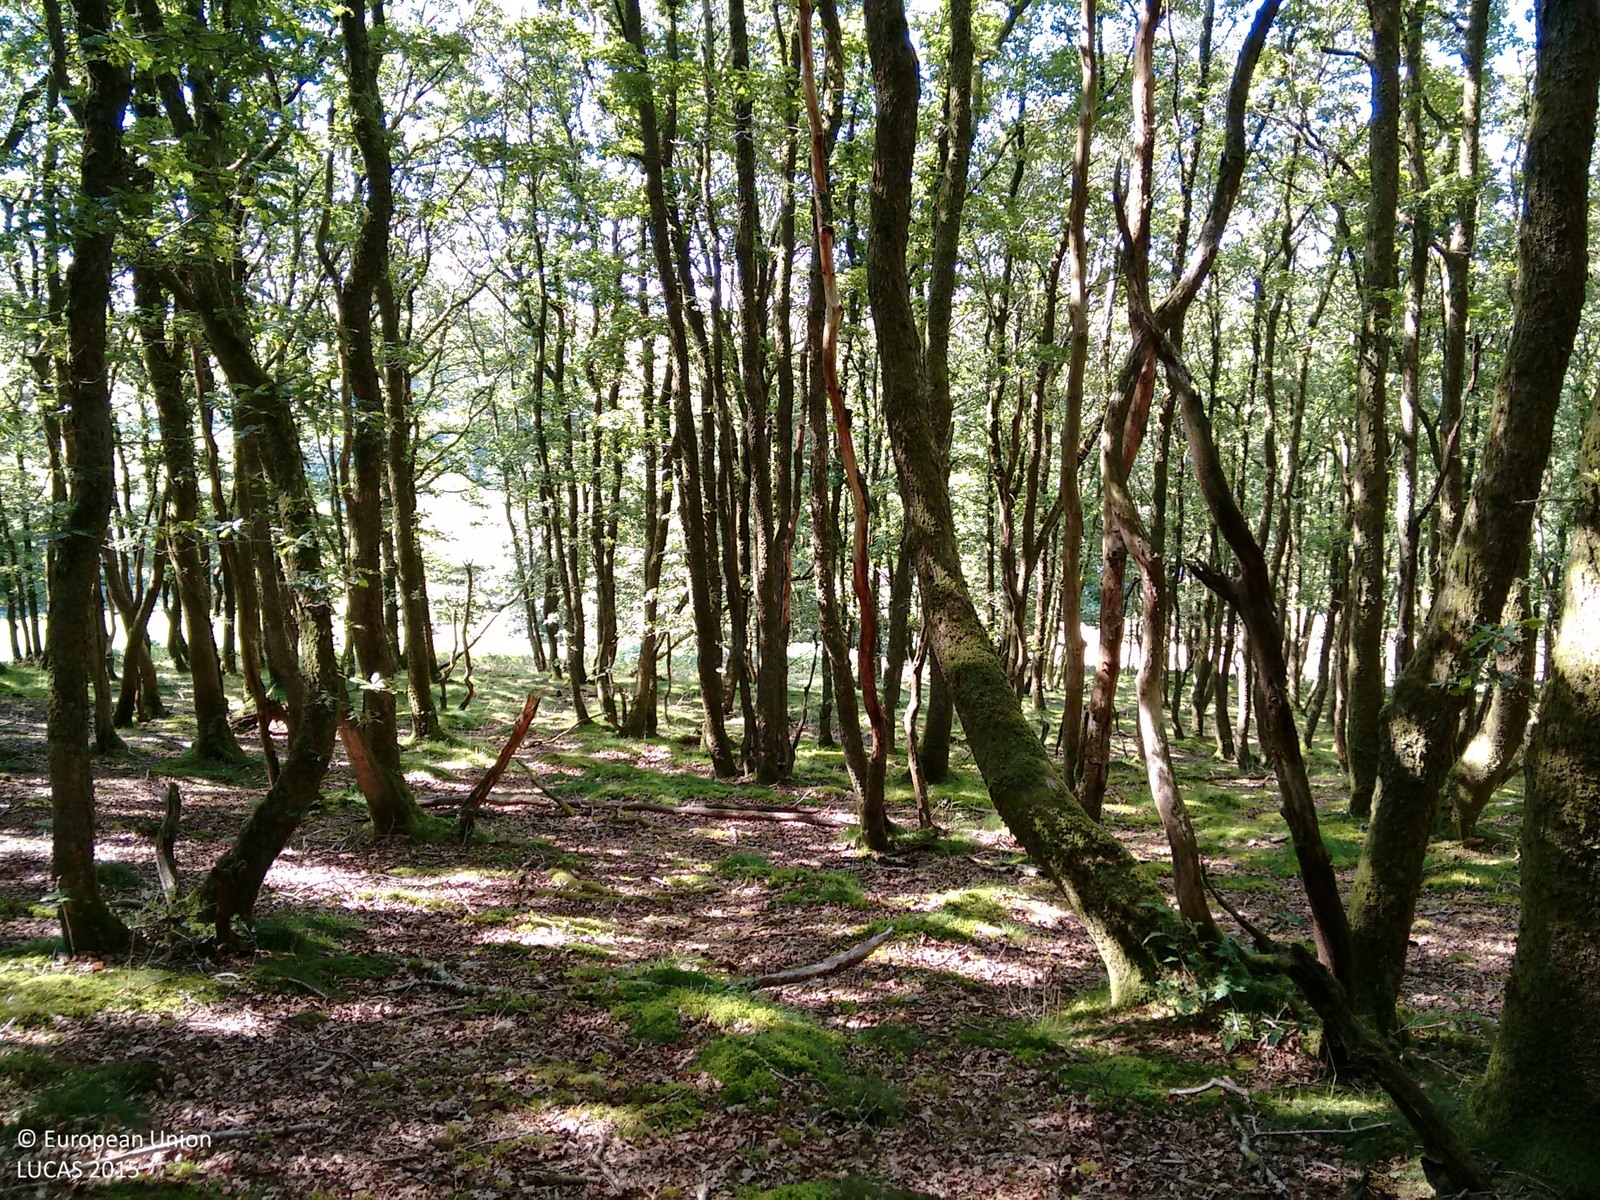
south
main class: Woodland
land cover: Broadleaved woodland
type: mesophytic deciduous forest
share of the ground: > 75 %
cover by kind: broadleaved forest trees 90 %, consolidated bare surface 10 %
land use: Semi-natural and natural areas not in use
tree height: > 5 m
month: August
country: GB
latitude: 52.0758
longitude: -4.1186
